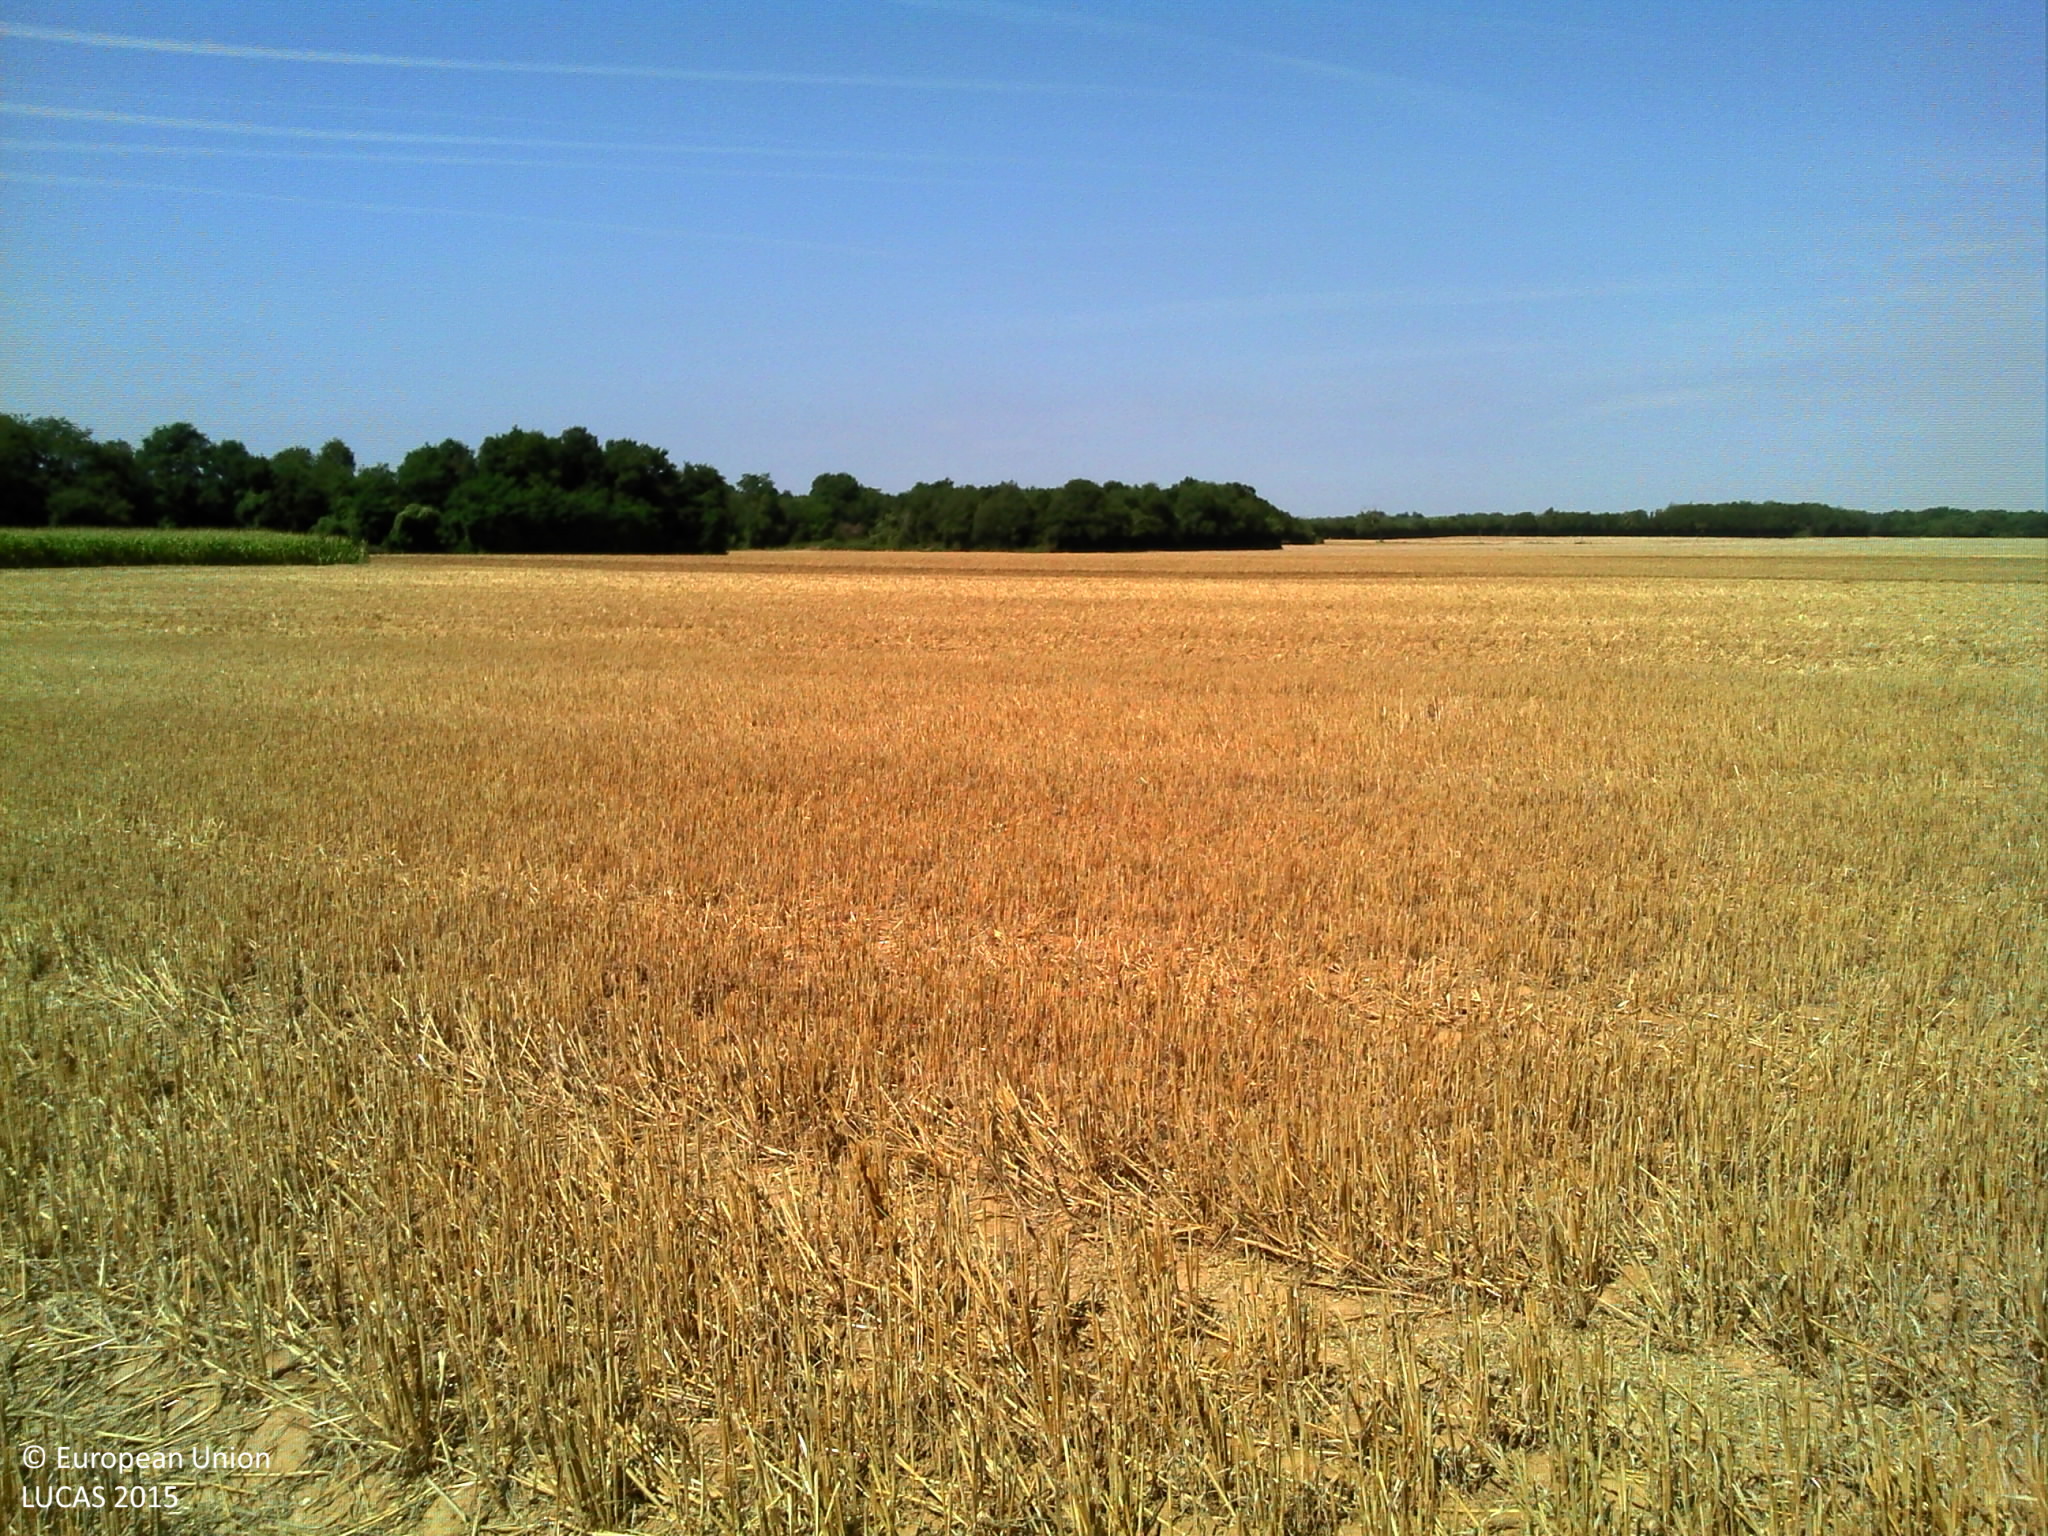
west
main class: Cropland
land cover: Common wheat
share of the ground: > 75 %
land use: Agriculture (excluding fallow land and kitchen gardens)
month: August
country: FR
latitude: 46.2222
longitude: 0.3500
